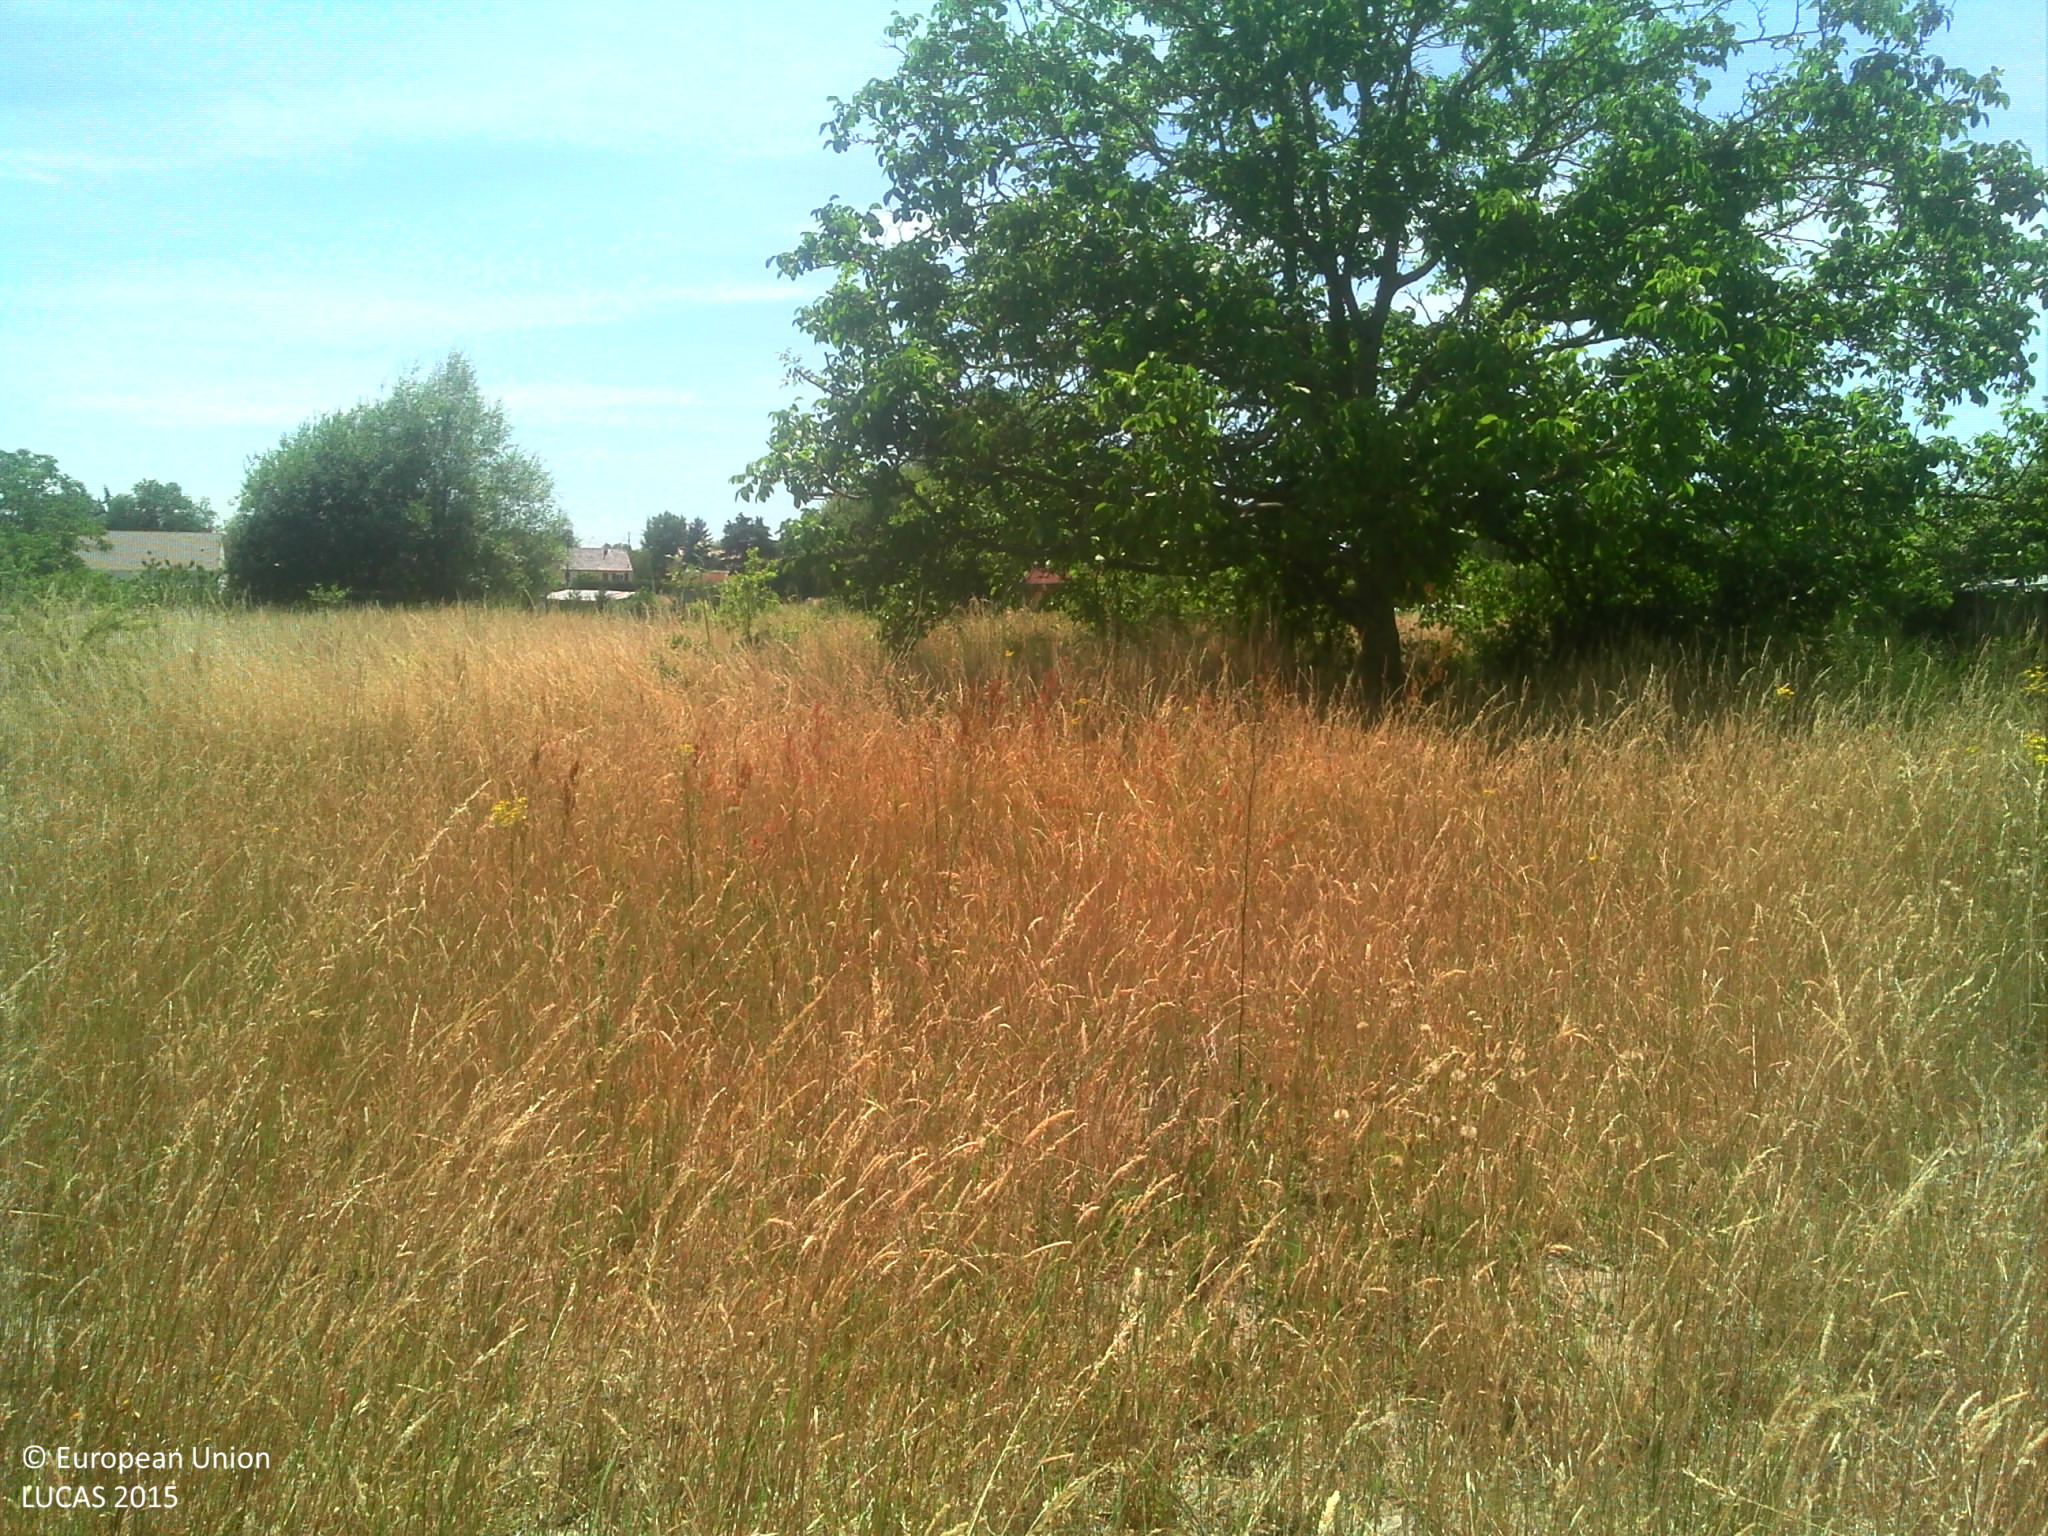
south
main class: Grassland
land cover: Spontaneously vegetated surfaces
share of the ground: > 75 %
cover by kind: herbaceous plants 60 %, unconsolidated bare surface 40 %
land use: Semi-natural and natural areas not in use
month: June
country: FR
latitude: 47.2847
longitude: 1.5653
